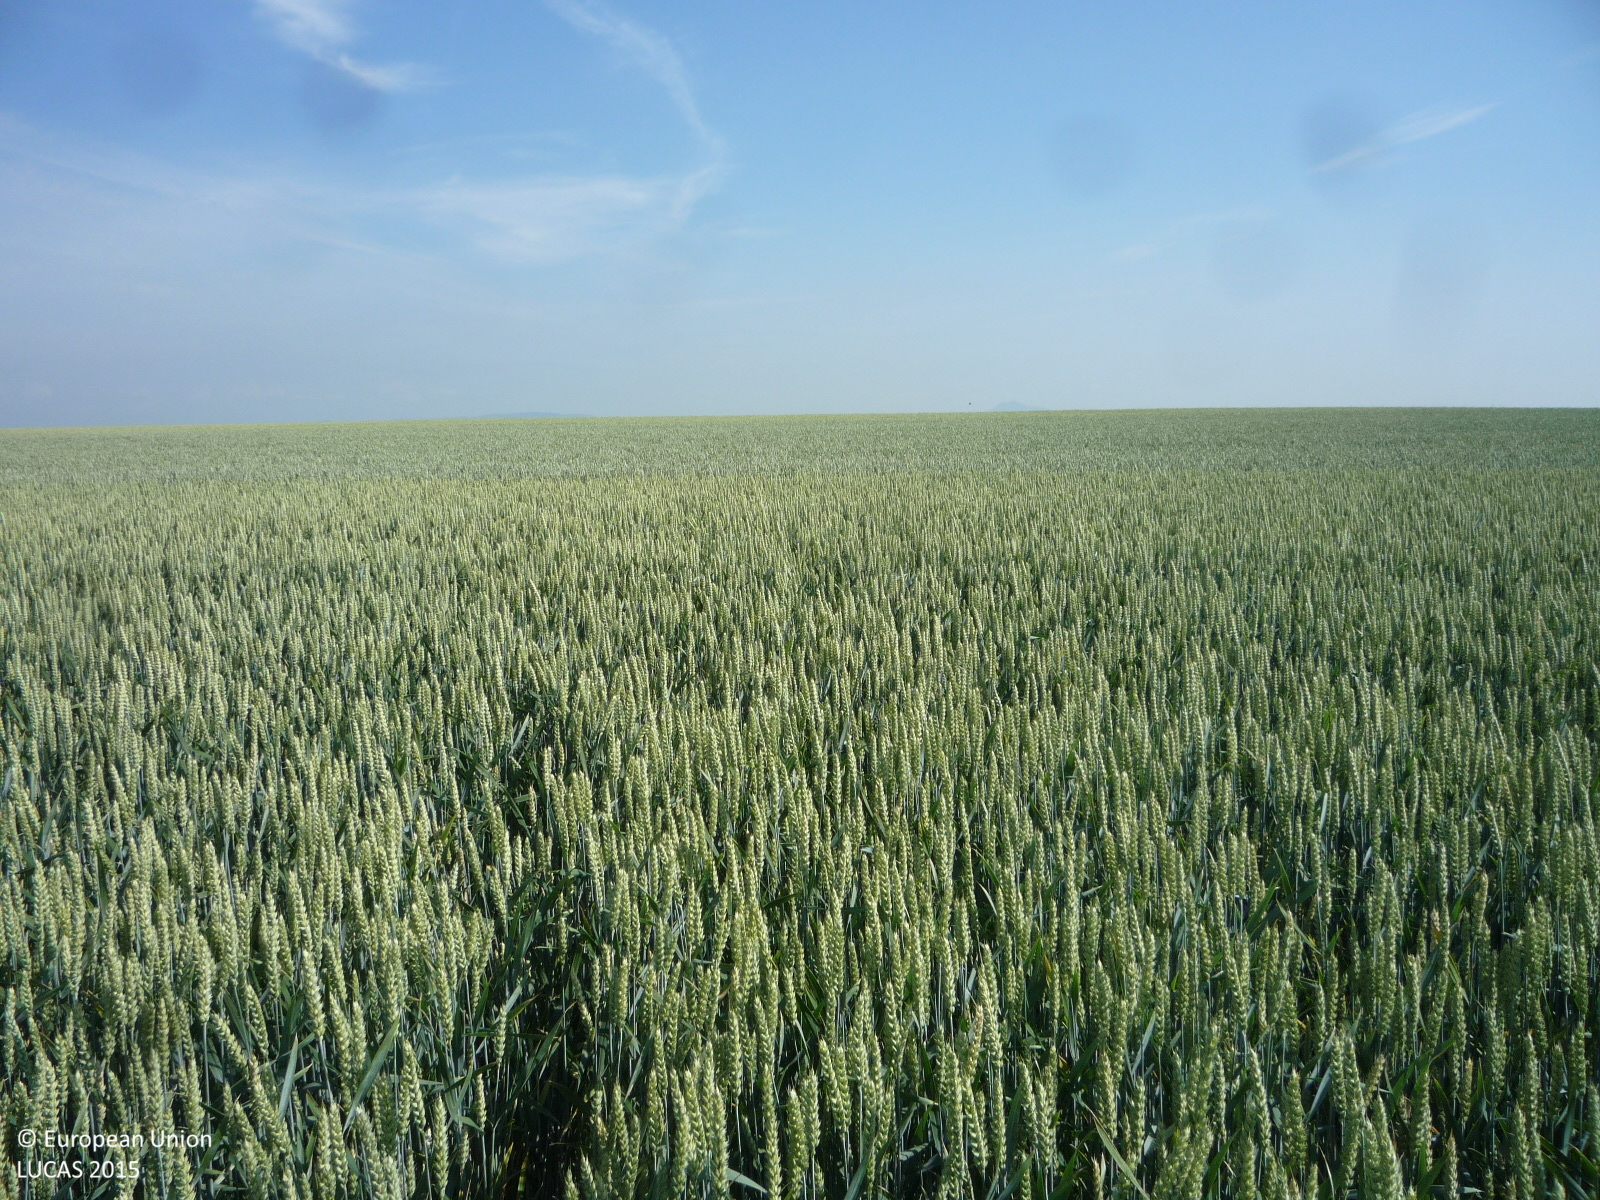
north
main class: Cropland
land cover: Common wheat
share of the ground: > 75 %
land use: Agriculture (excluding fallow land and kitchen gardens)
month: June
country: CZ
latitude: 50.3778
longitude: 14.1776
